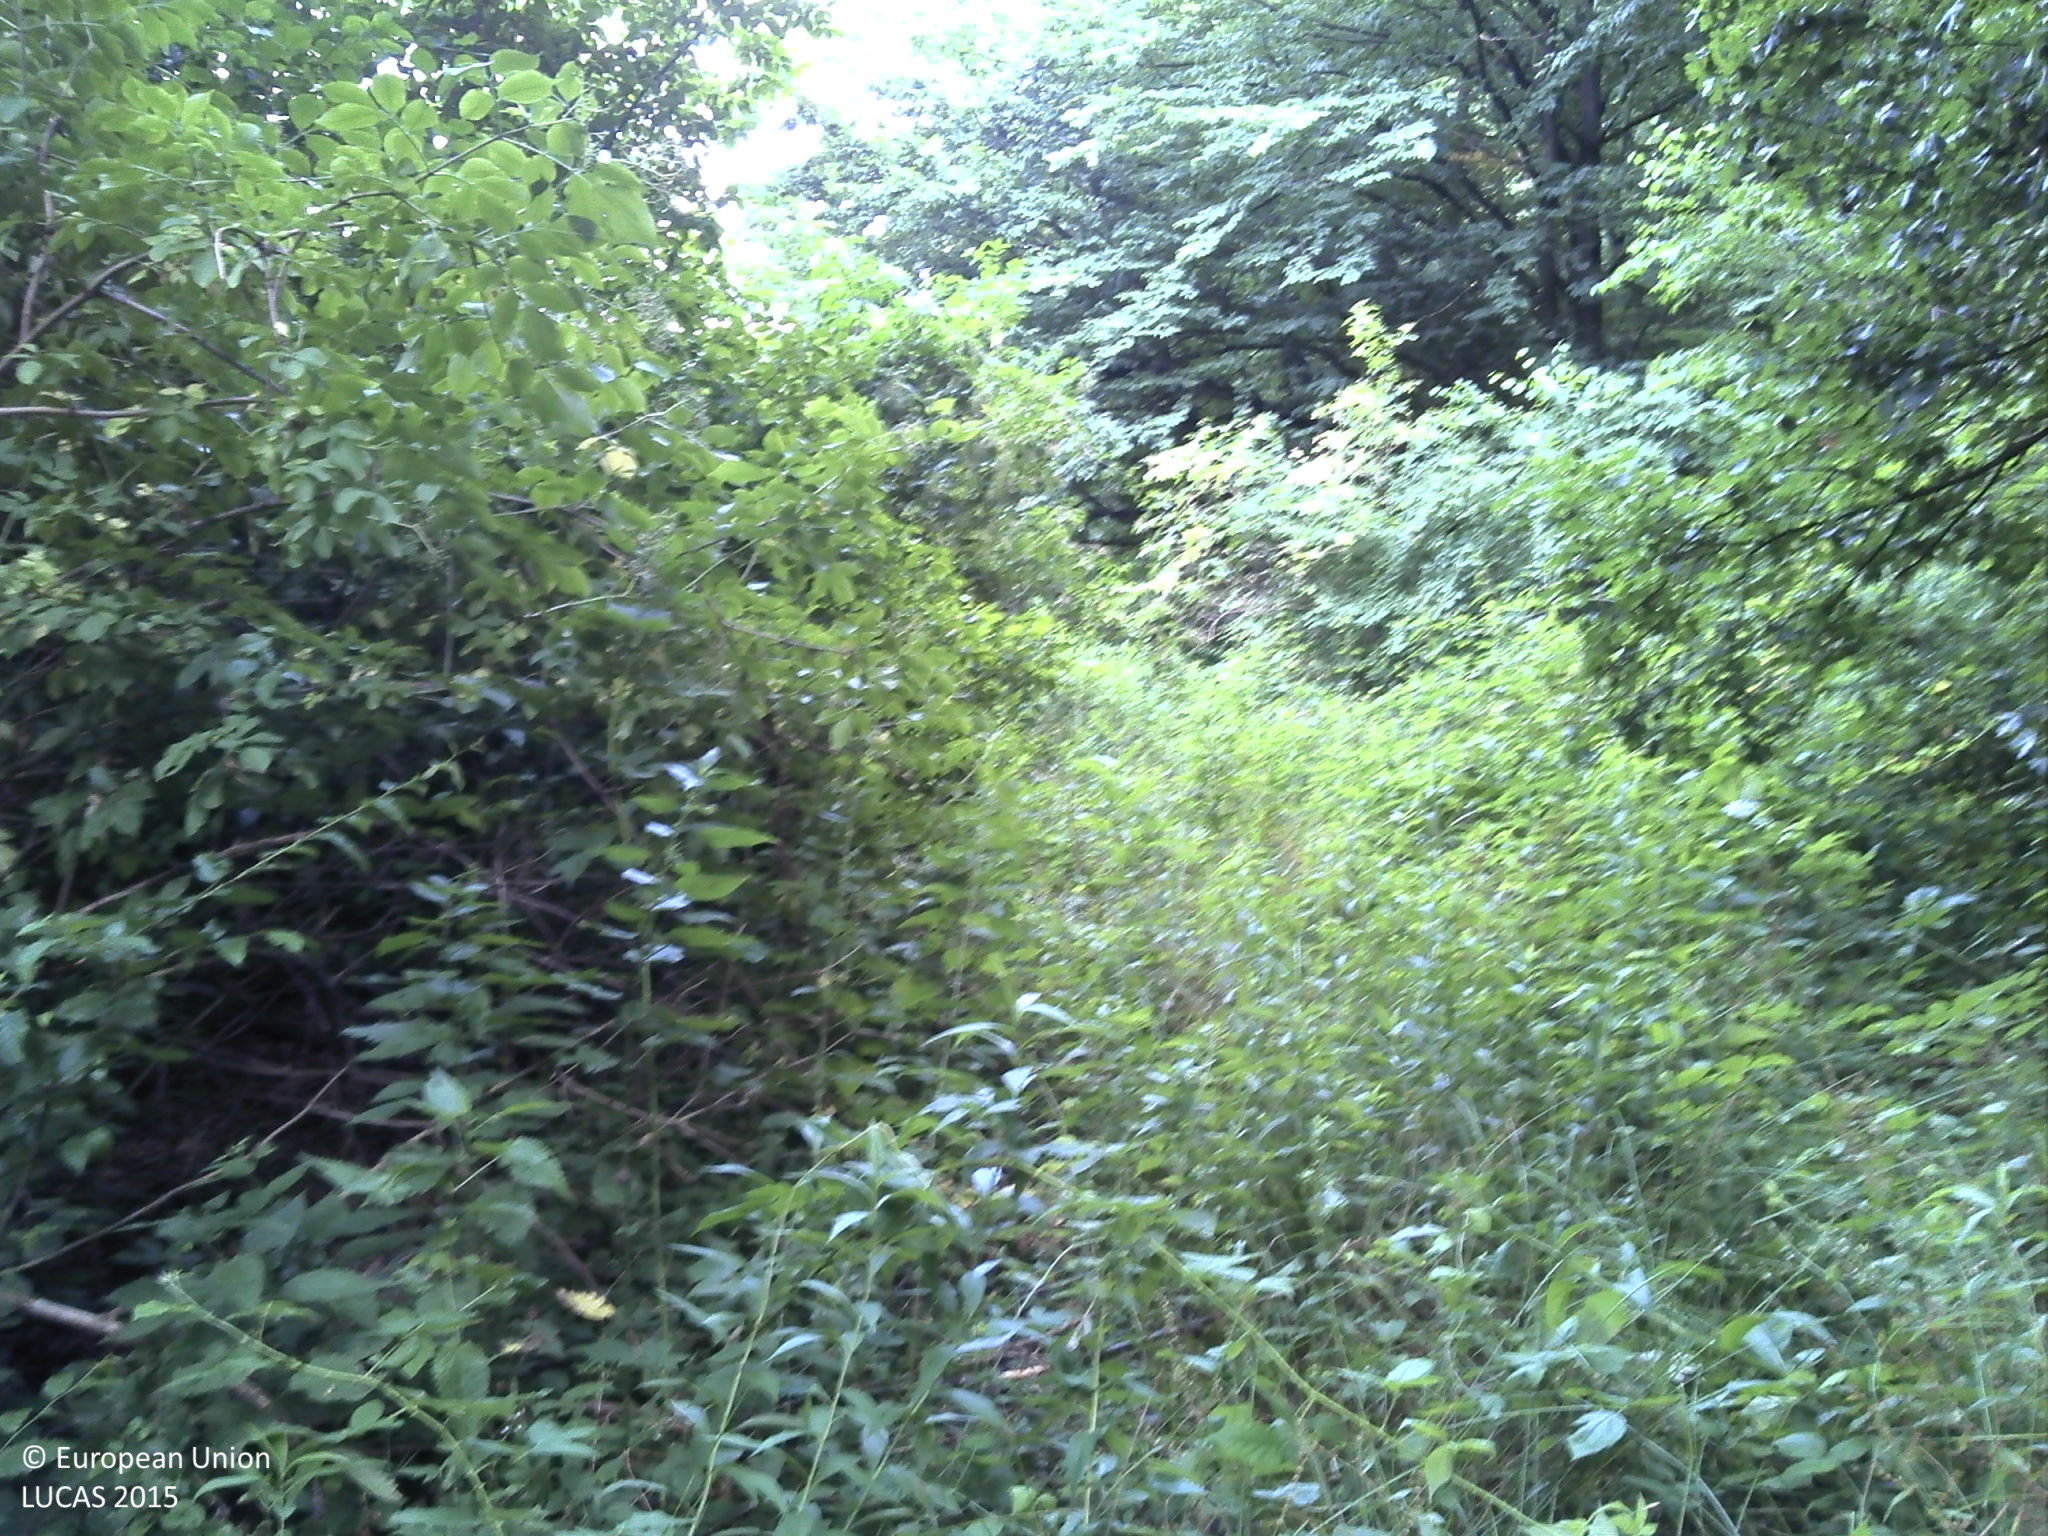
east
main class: Woodland
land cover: Broadleaved woodland
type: acidophilous oak and oak-birch forest
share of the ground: > 75 %
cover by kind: broadleaved forest trees 100 %
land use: Forestry
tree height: > 5 m
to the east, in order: Broadleaved woodland; Grassland without tree/shrub cover; Tracks
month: June
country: HR
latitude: 45.4186
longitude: 18.4528
